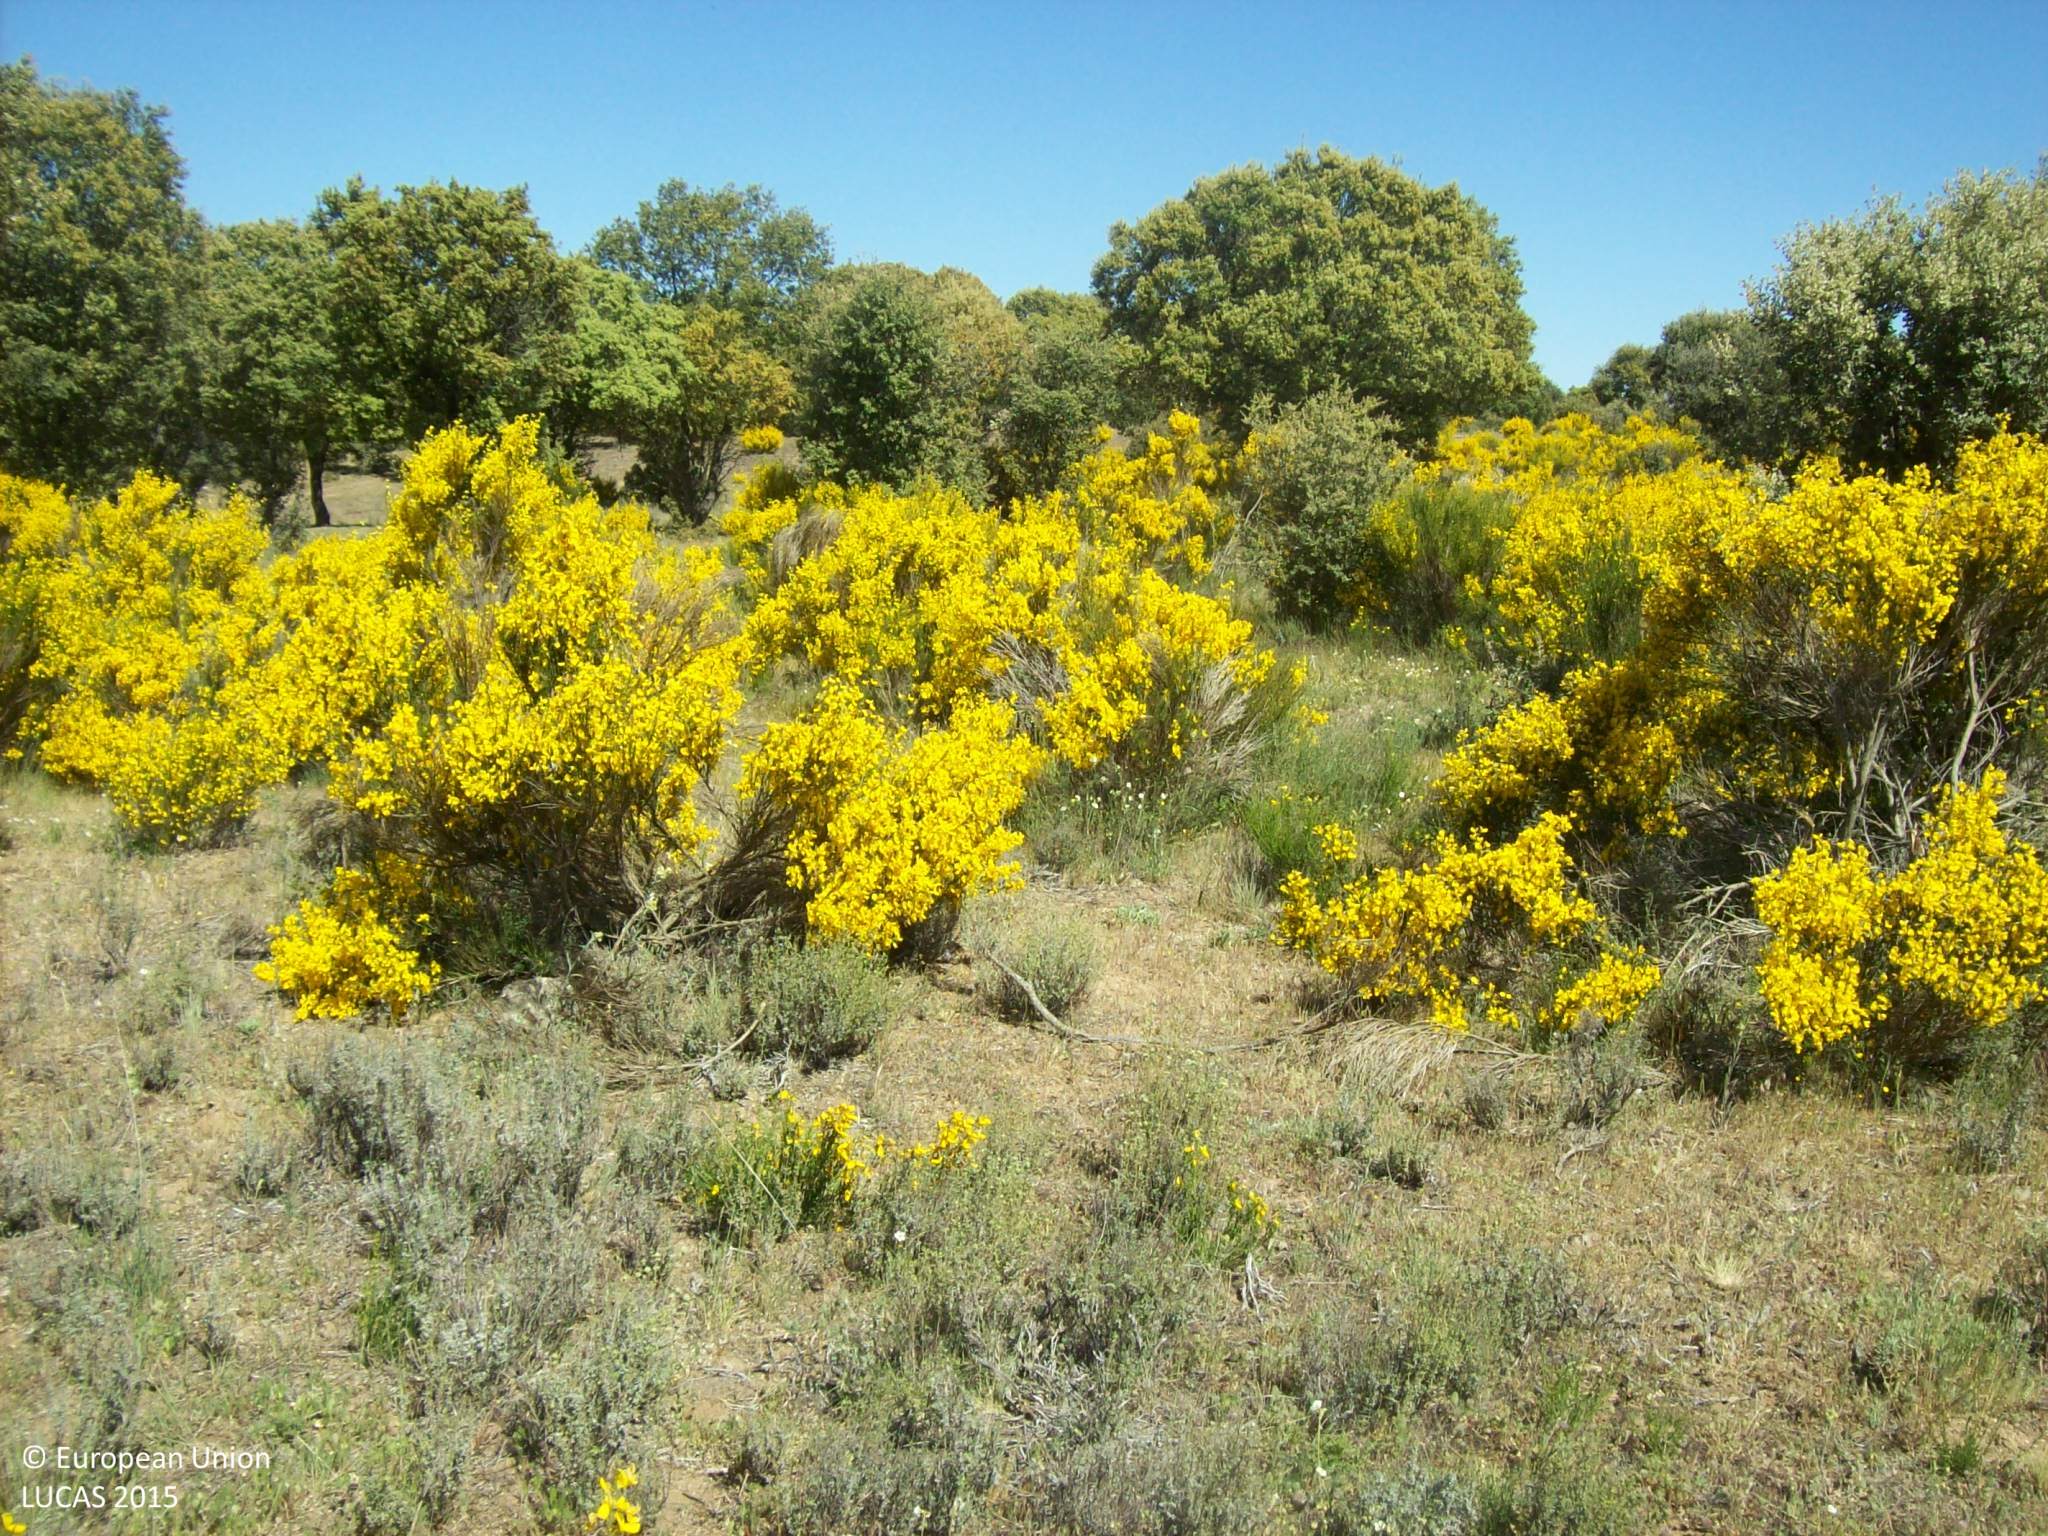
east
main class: Woodland
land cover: Broadleaved woodland
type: acidophilous oak and oak-birch forest
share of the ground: 10 - 25 %
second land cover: Shrubland without tree cover
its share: 50 - 75 %
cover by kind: shrubs 40 %, herbaceous plants 40 %, broadleaved forest trees 10 %, lichens and mosses 10 %
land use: Forestry
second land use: Agriculture (excluding fallow land and kitchen gardens)
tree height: > 5 m
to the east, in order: Broadleaved woodland; Shrubland without tree cover; Tracks; Fences; Broadleaved woodland; Tracks; Broadleaved woodland
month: May
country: ES
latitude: 40.7275
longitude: -4.9674
